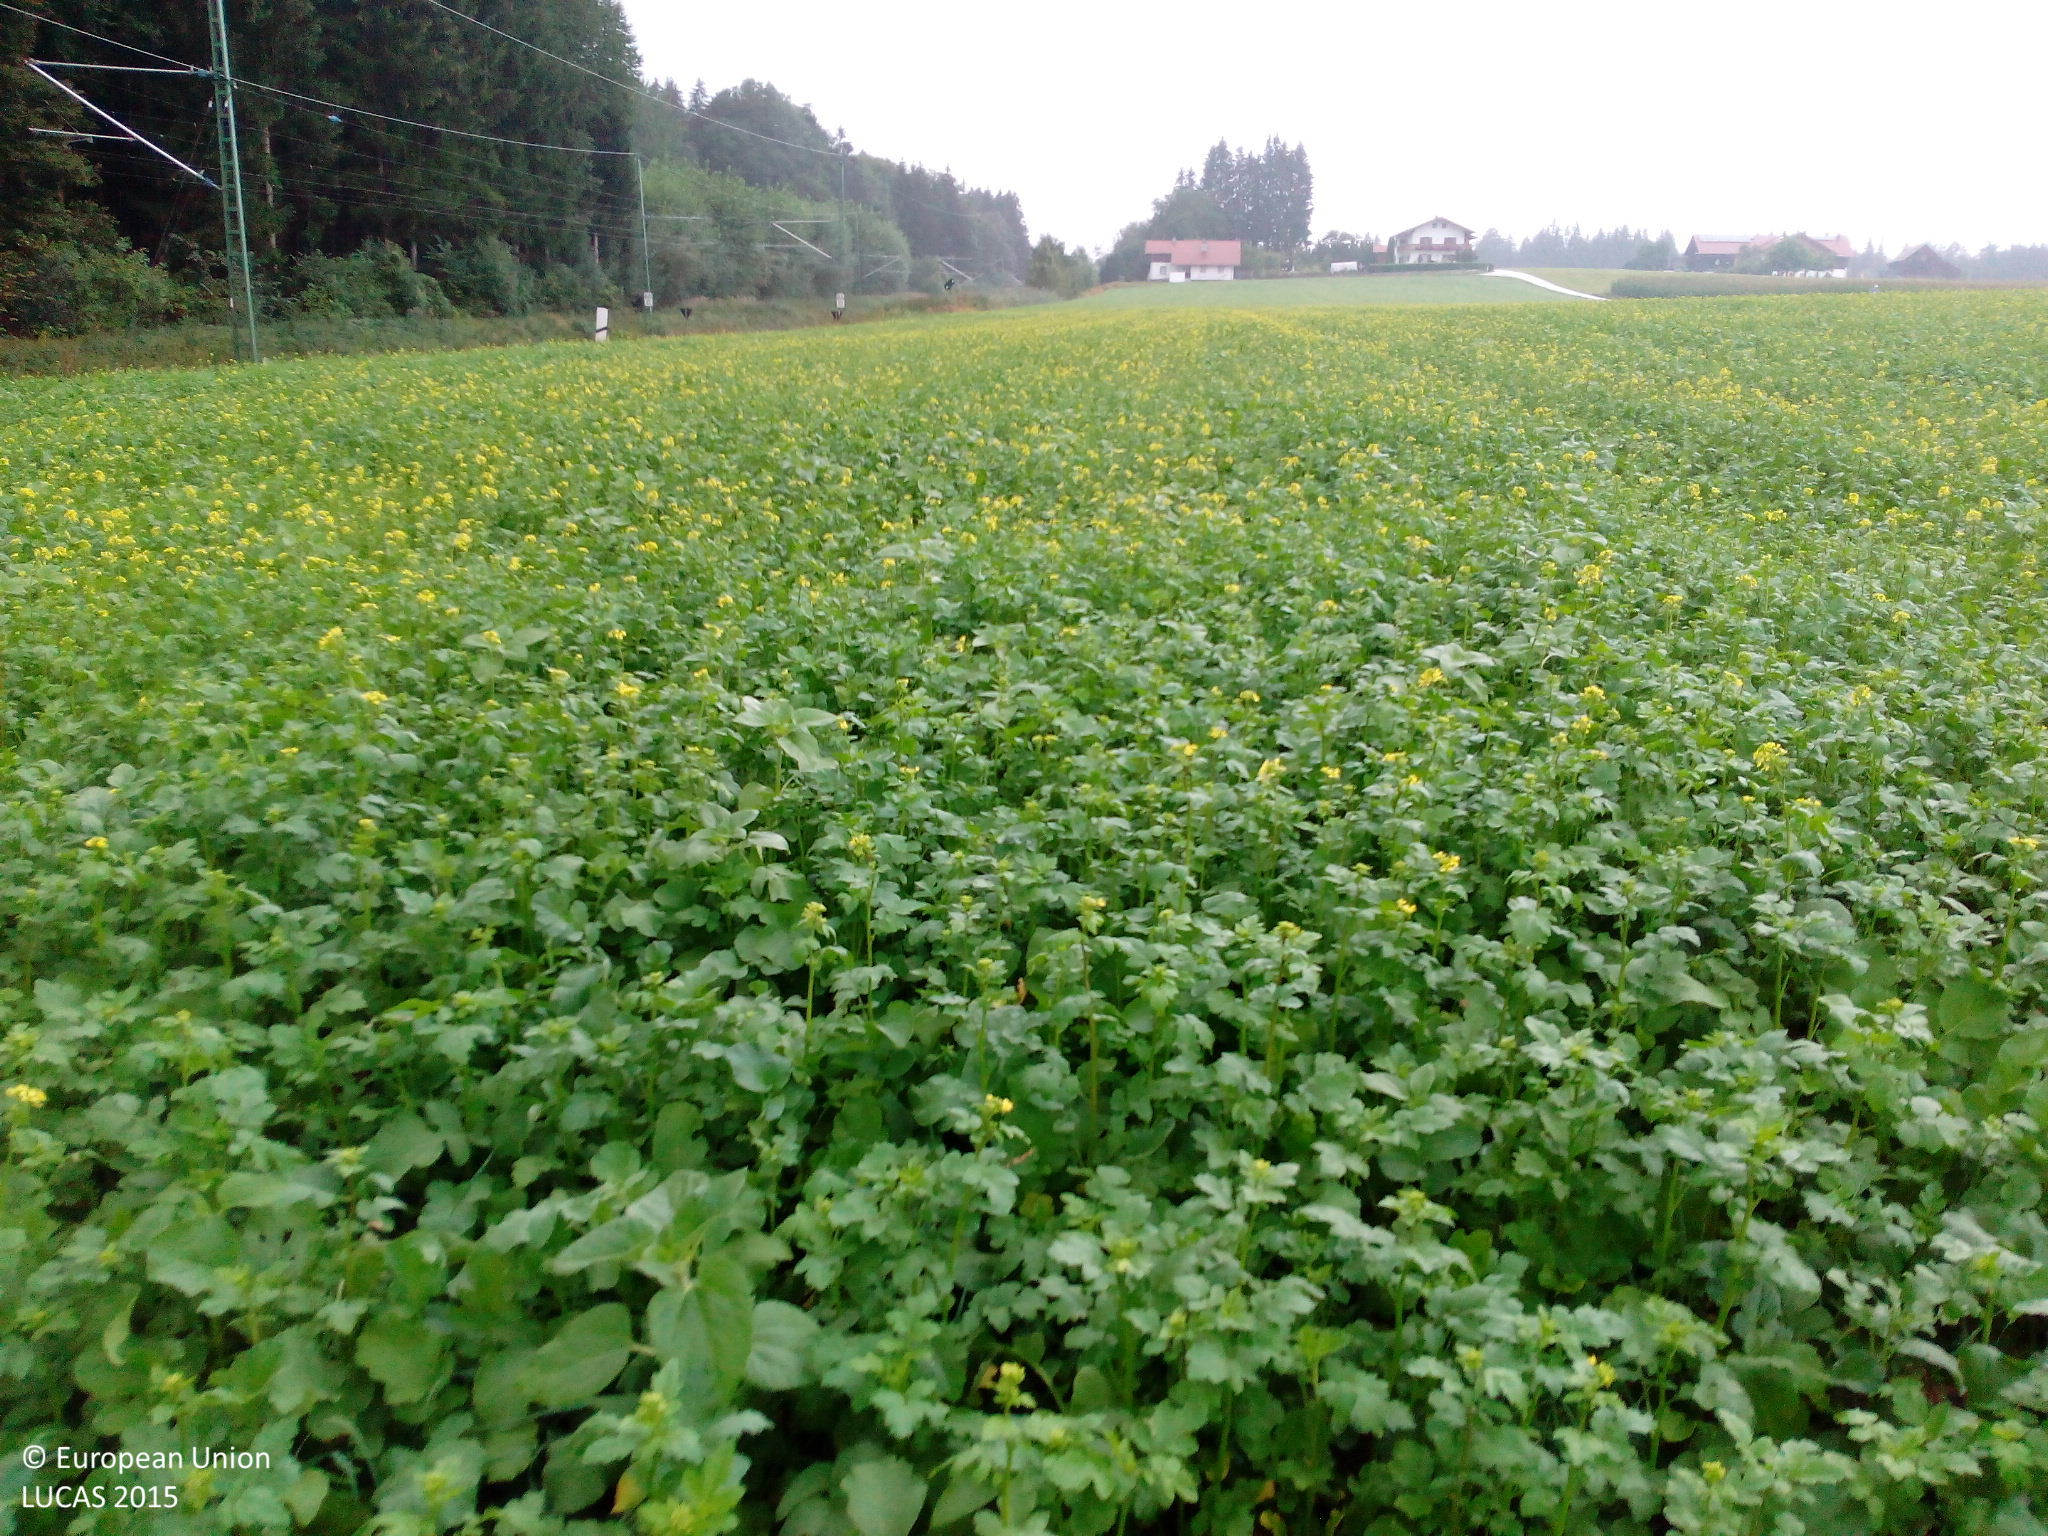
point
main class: Cropland
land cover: Potatoes
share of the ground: > 75 %
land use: Agriculture (excluding fallow land and kitchen gardens)
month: August
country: DE
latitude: 47.8641
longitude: 12.7925
